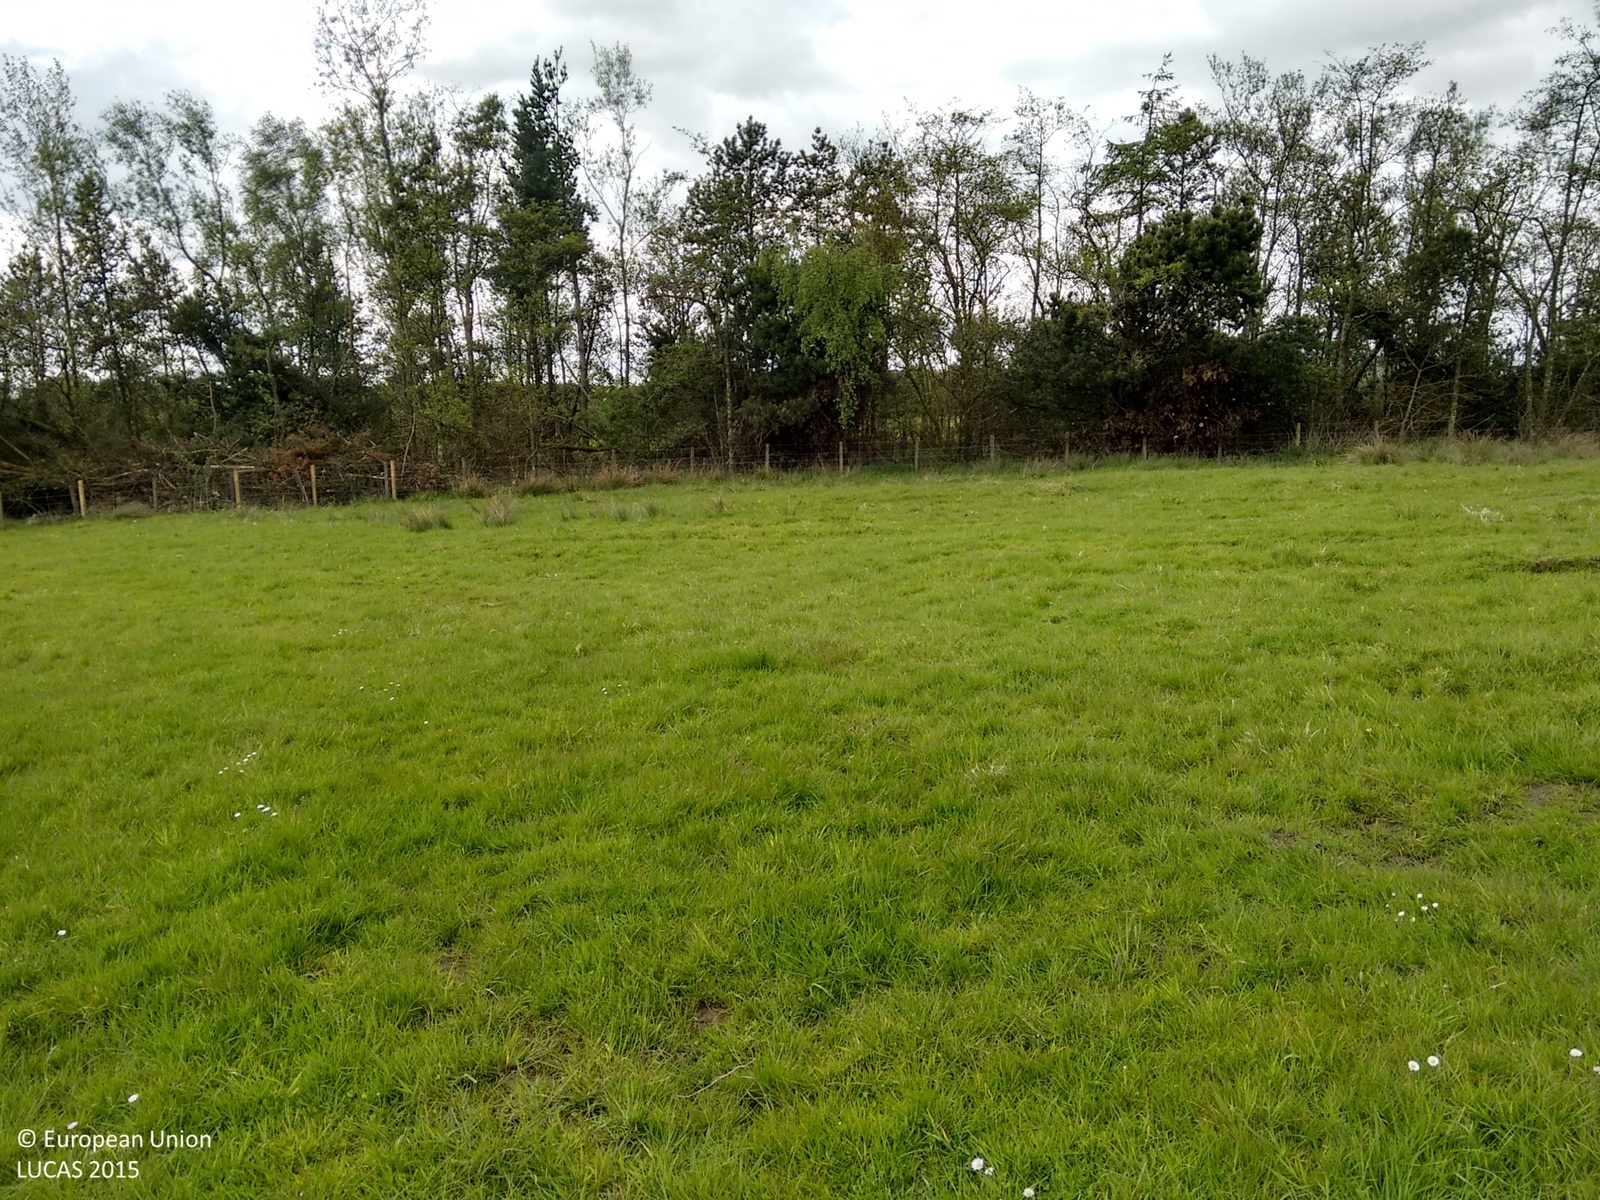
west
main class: Grassland
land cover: Grassland without tree/shrub cover
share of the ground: > 75 %
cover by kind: herbaceous plants 100 %
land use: Agriculture (excluding fallow land and kitchen gardens)
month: May
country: GB
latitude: 56.1377
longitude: -3.7436
